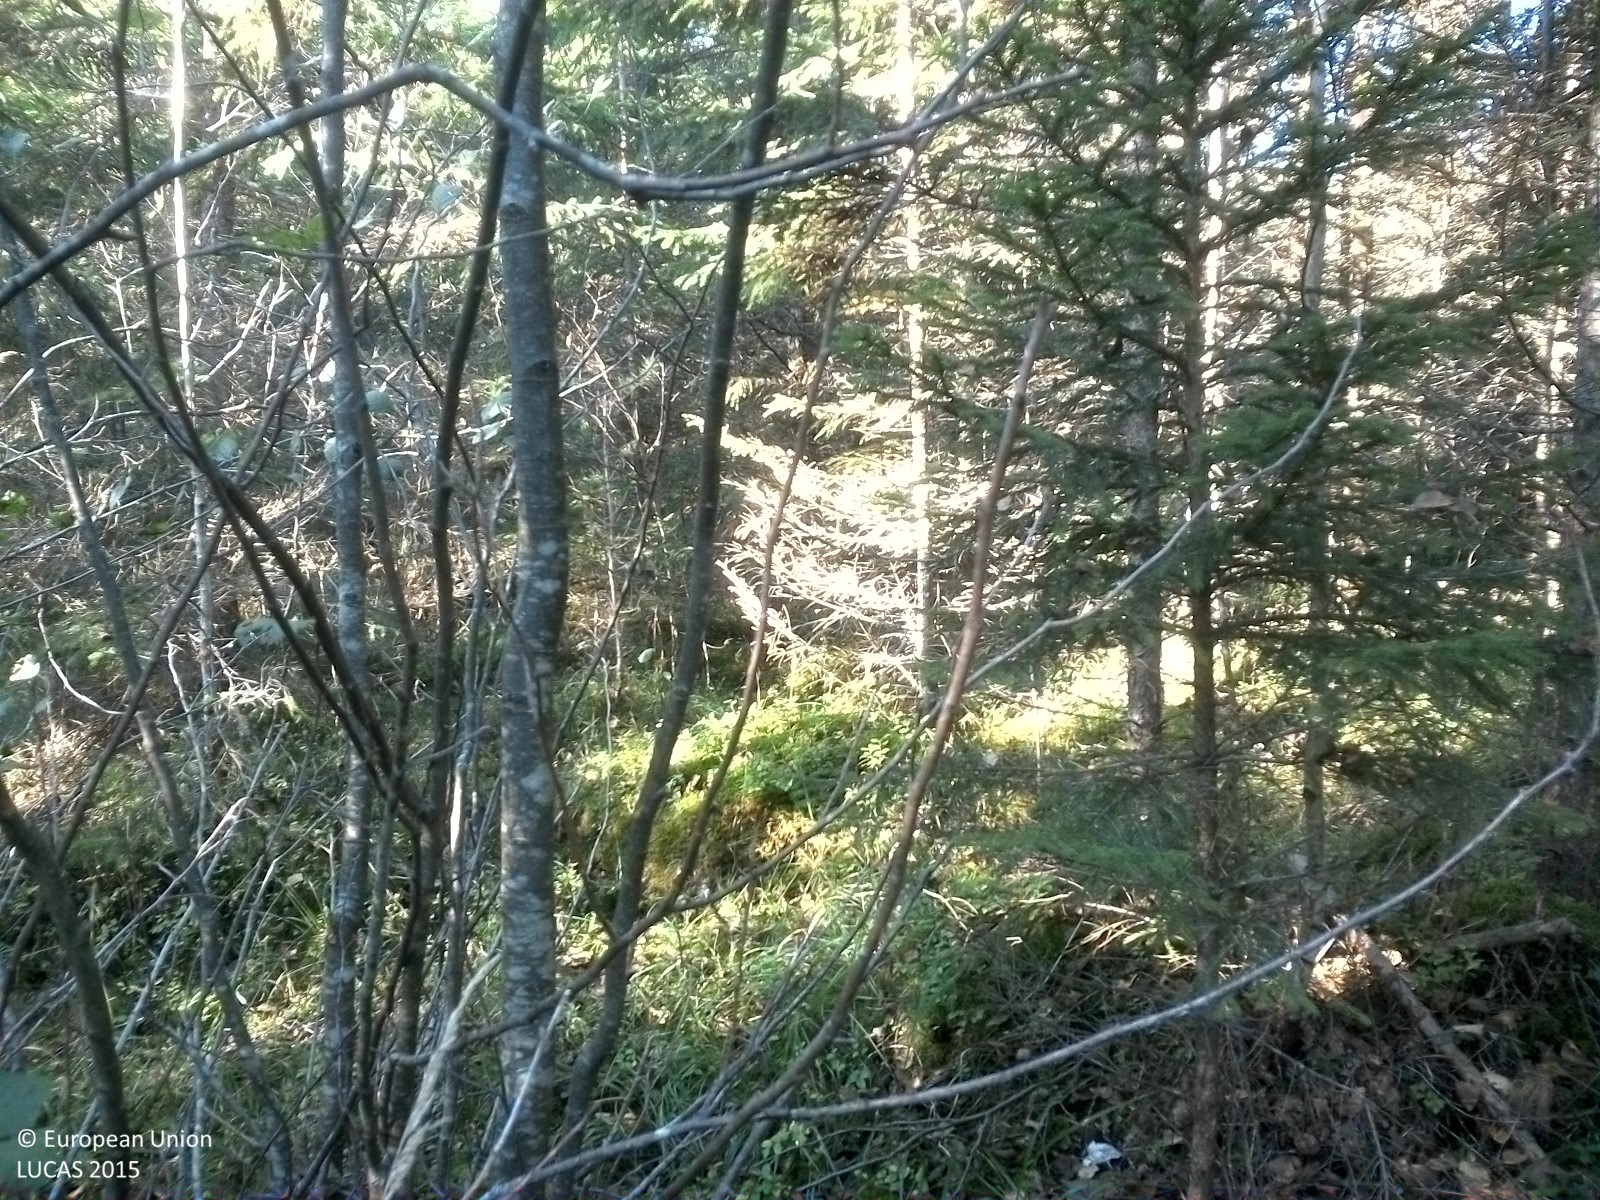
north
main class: Woodland
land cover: Spruce dominated mixed woodland
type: boreal forest
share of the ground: 50 - 75 %
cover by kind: coniferous forest trees 35 %, herbaceous plants 30 %, broadleaved forest trees 25 %, lichens and mosses 10 %
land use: Forestry
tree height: < 5 m
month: September
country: SE
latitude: 58.7803
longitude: 16.5857
